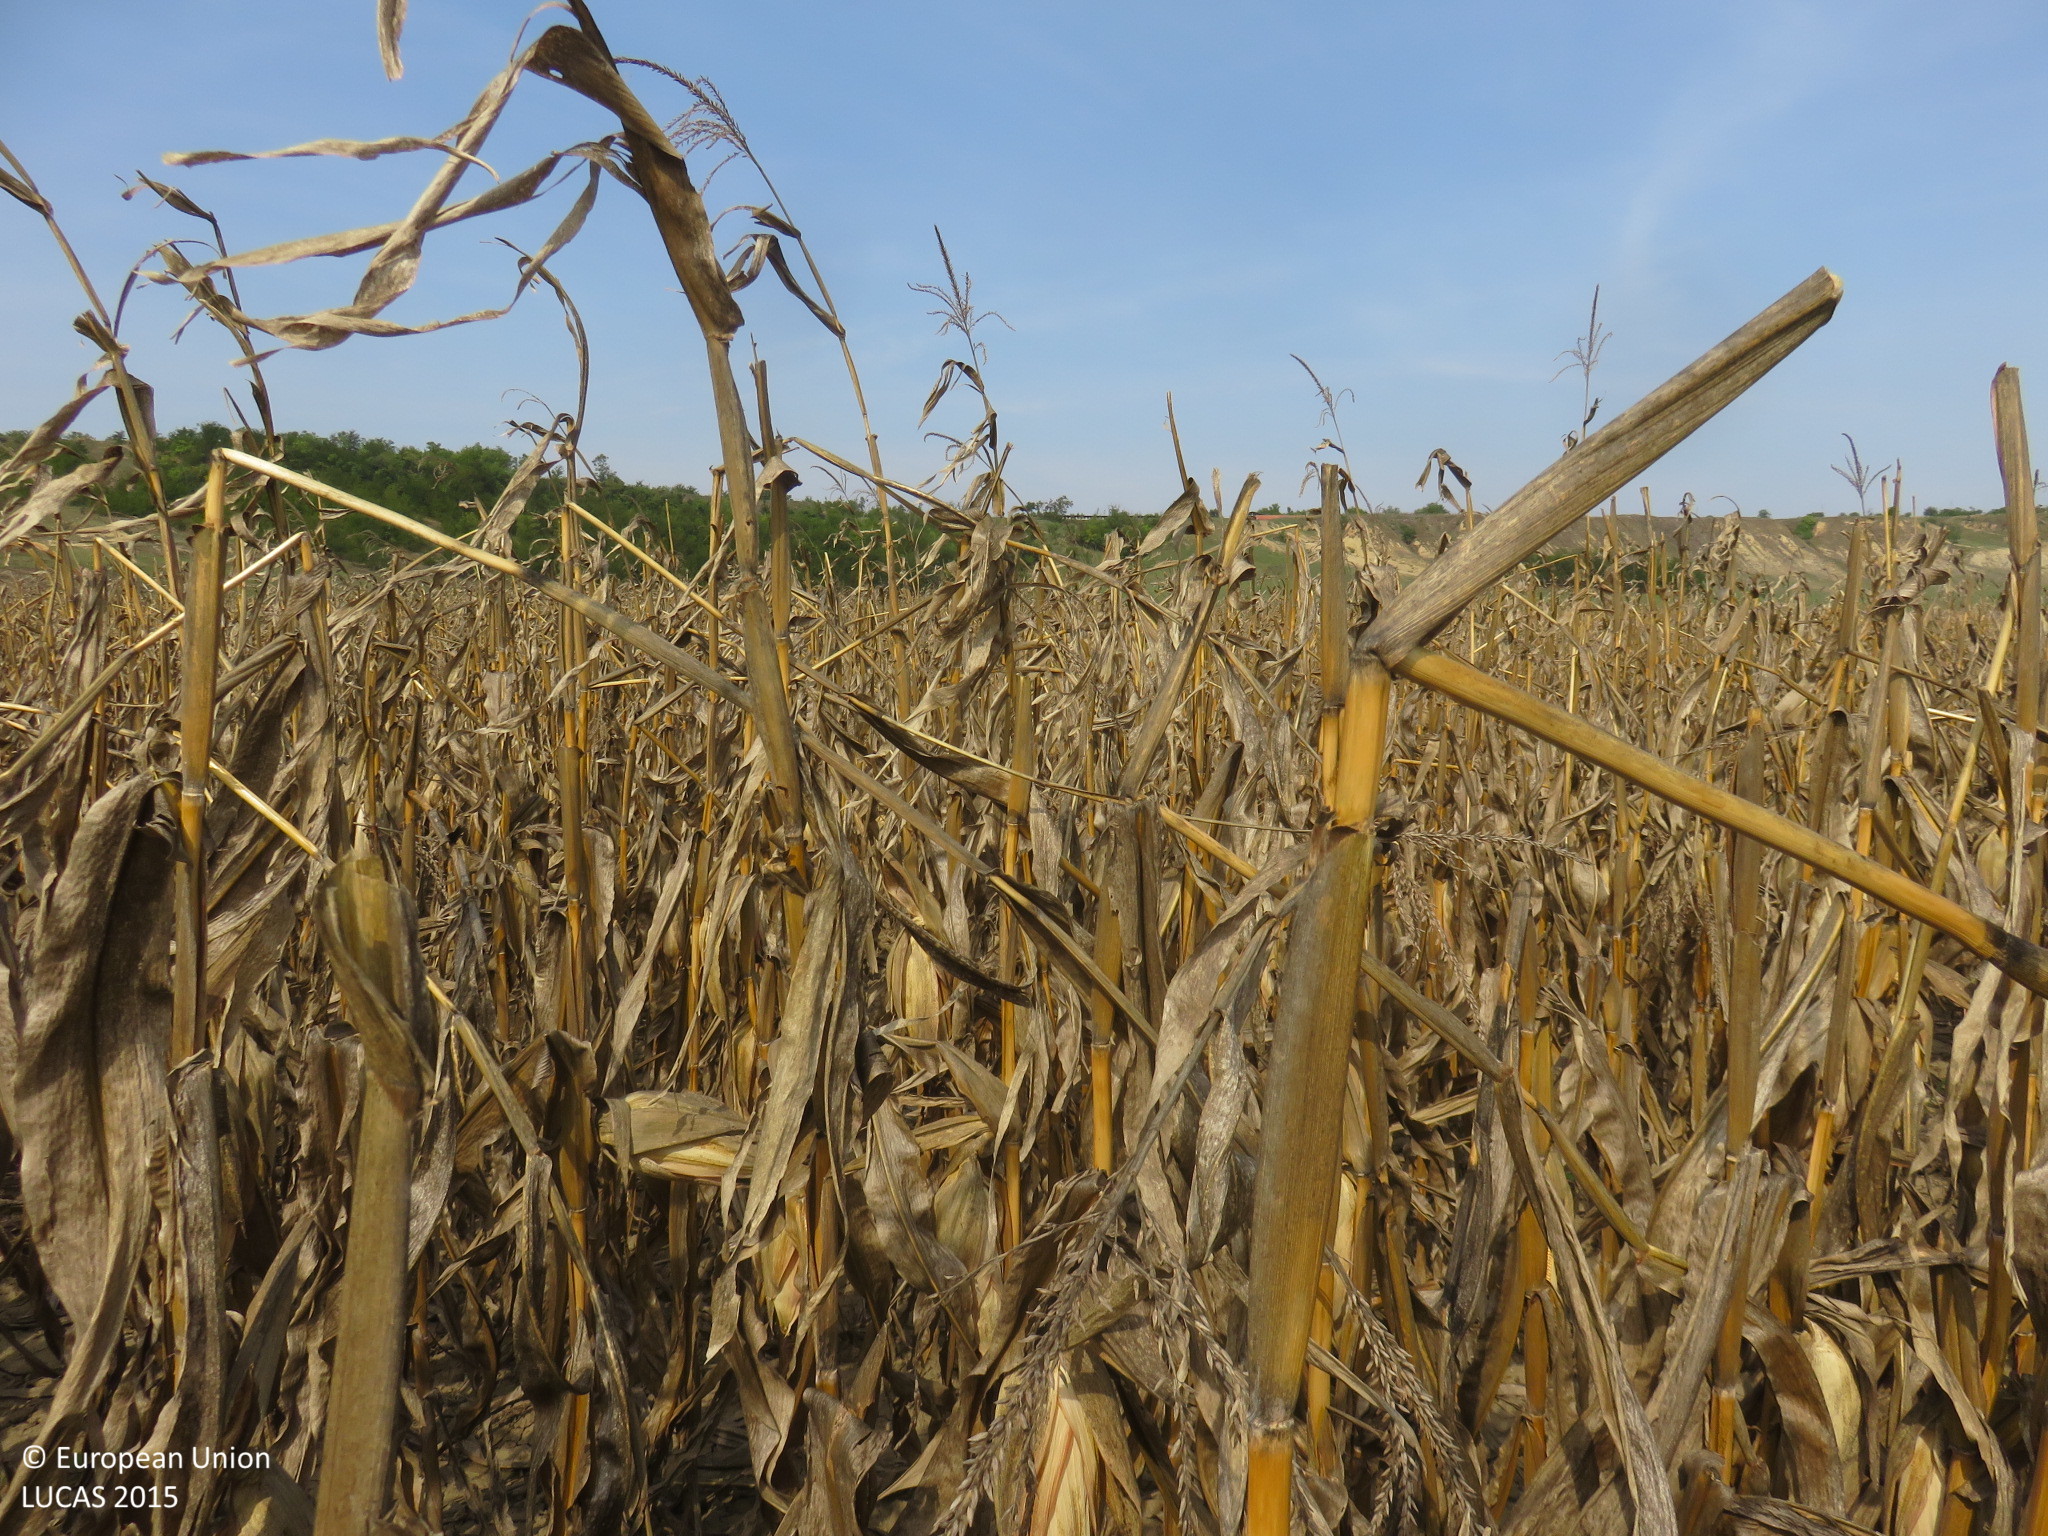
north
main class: Cropland
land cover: Maize
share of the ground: > 75 %
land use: Agriculture (excluding fallow land and kitchen gardens)
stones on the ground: < 10 %
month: September
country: BG
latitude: 43.4740
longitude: 24.9919
